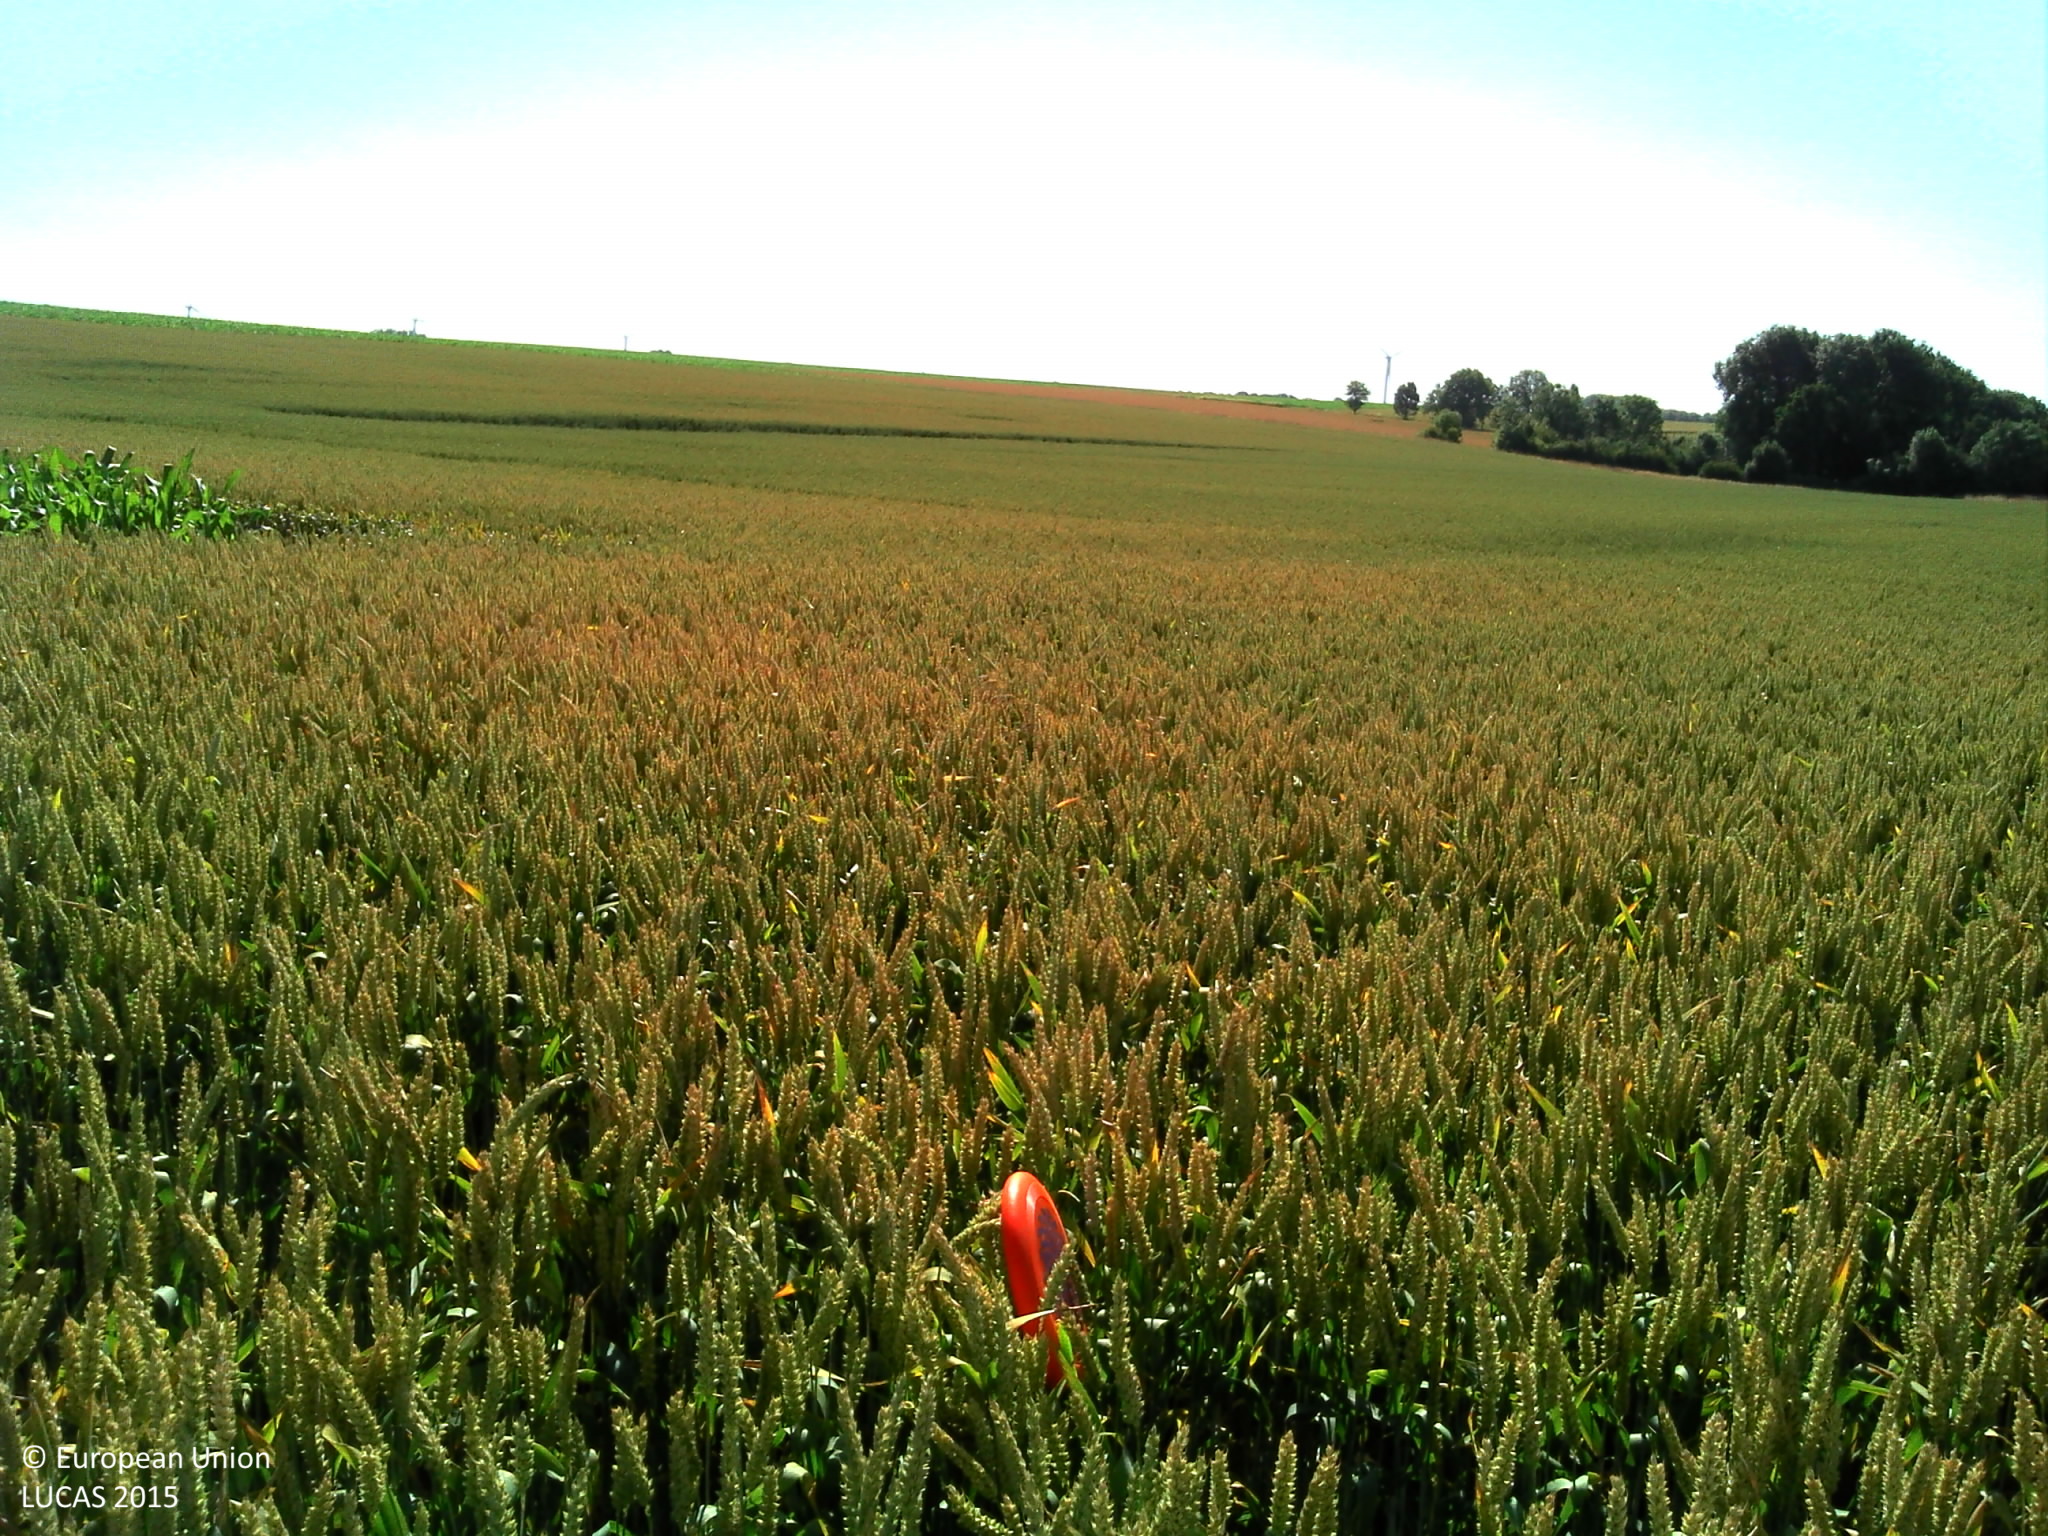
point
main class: Cropland
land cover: Common wheat
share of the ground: > 75 %
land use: Agriculture (excluding fallow land and kitchen gardens)
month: July
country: FR
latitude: 50.2601
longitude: 2.2006
